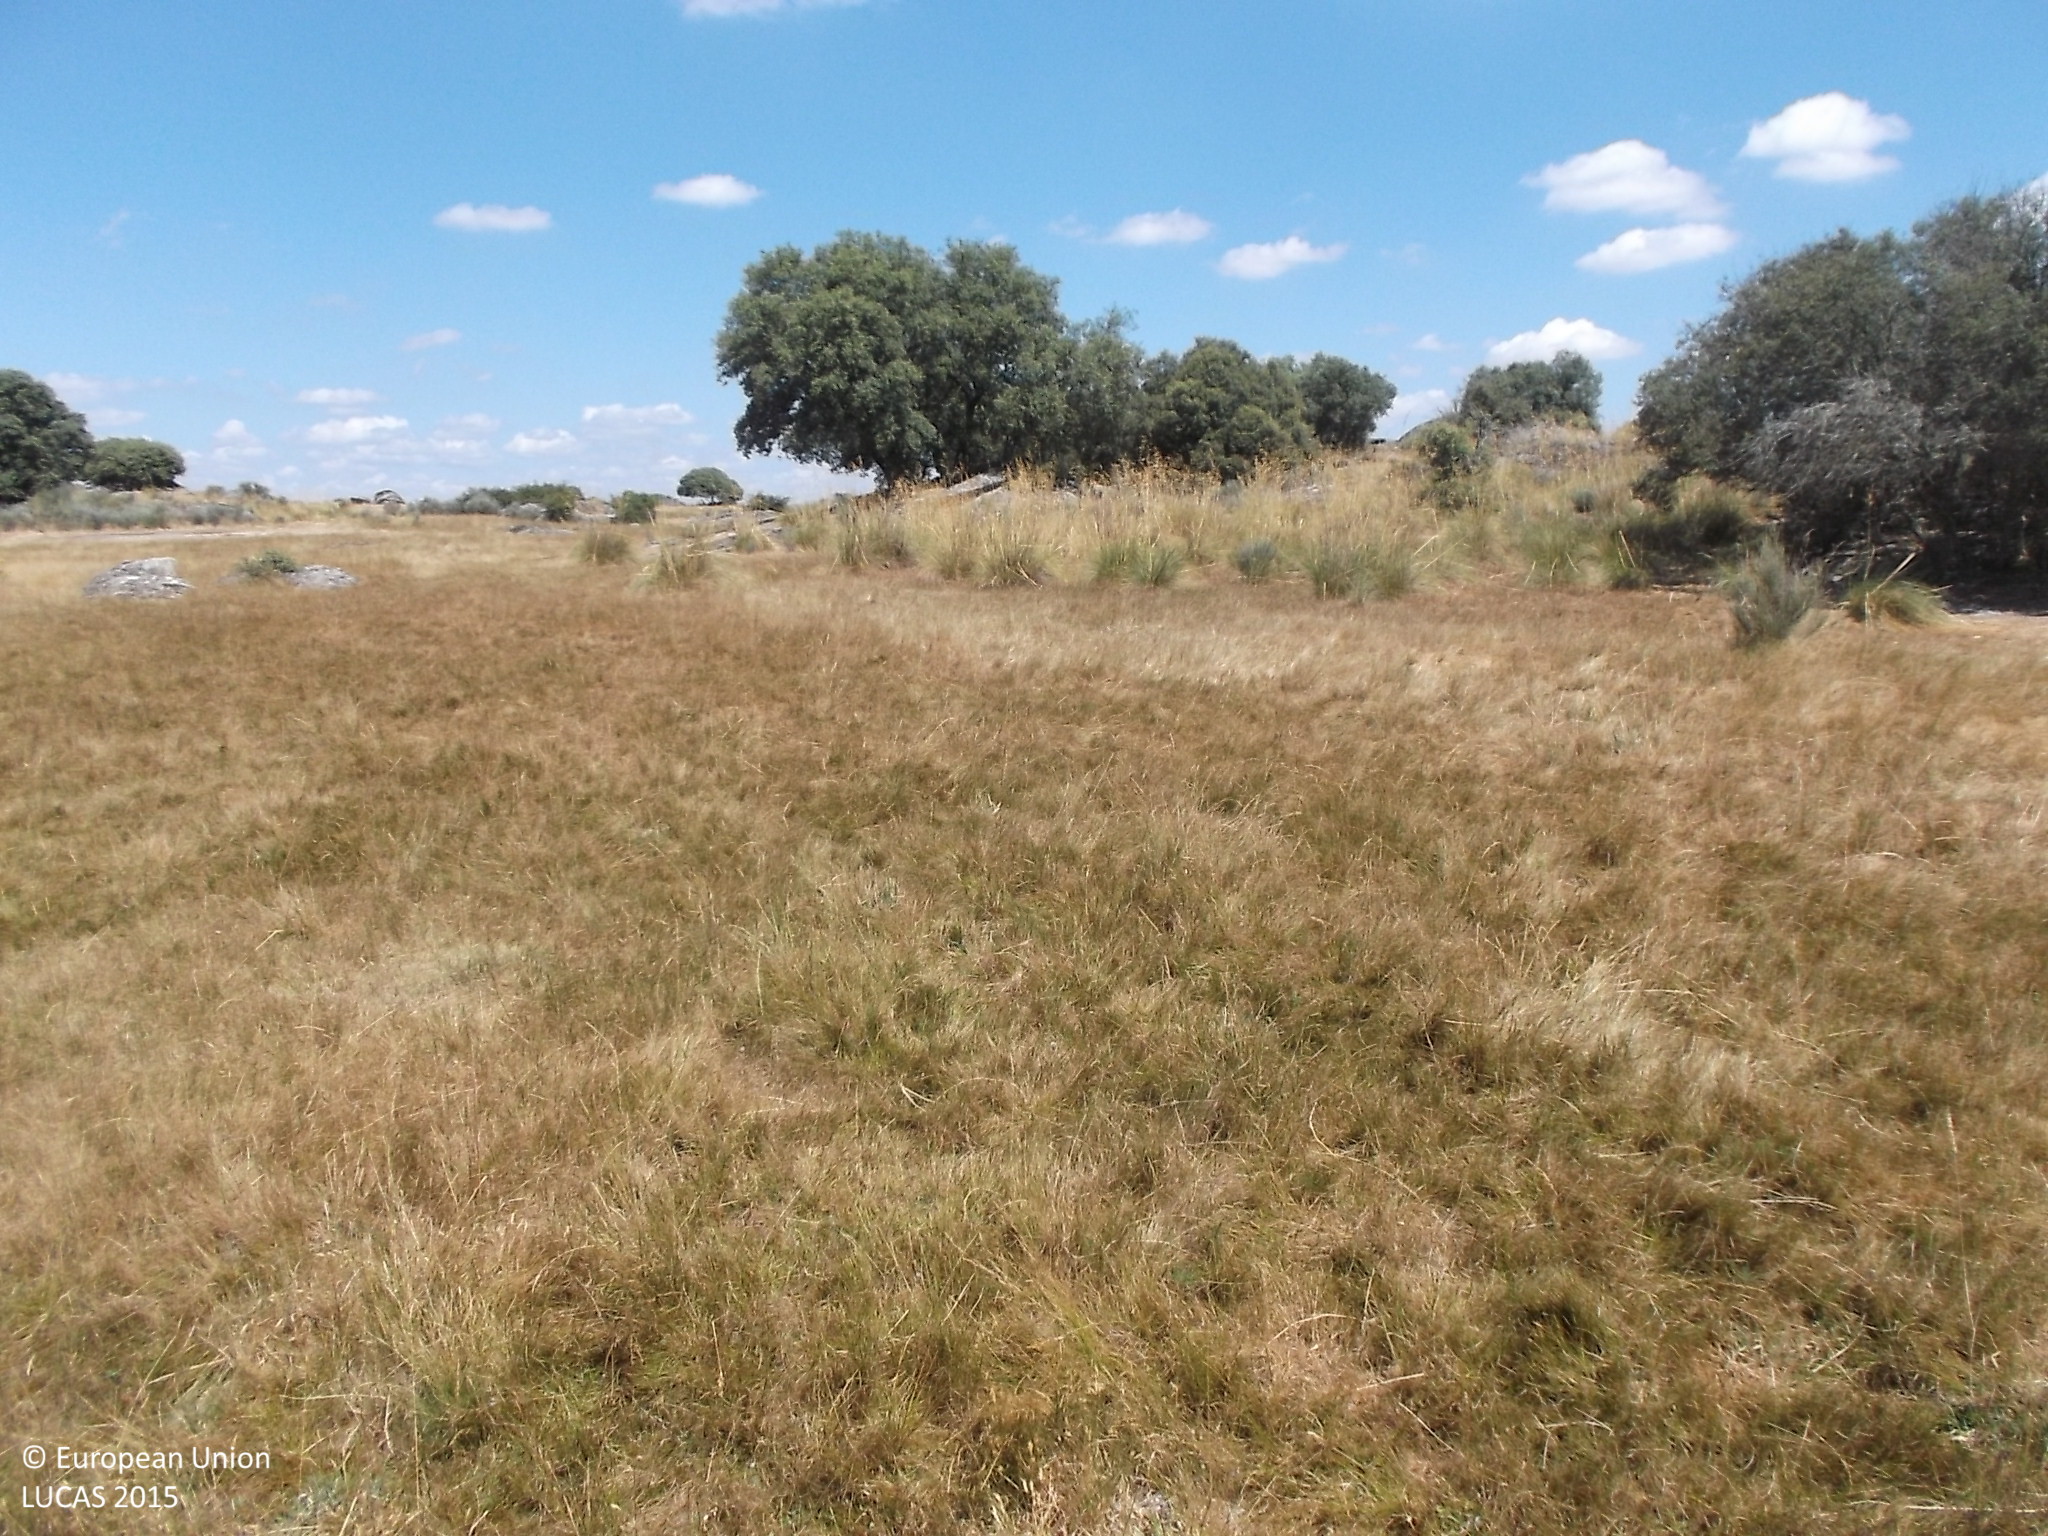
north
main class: Grassland
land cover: Grassland without tree/shrub cover
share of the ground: > 75 %
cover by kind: herbaceous plants 100 %
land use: Agriculture (excluding fallow land and kitchen gardens)
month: July
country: ES
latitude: 41.4210
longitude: -6.0407
